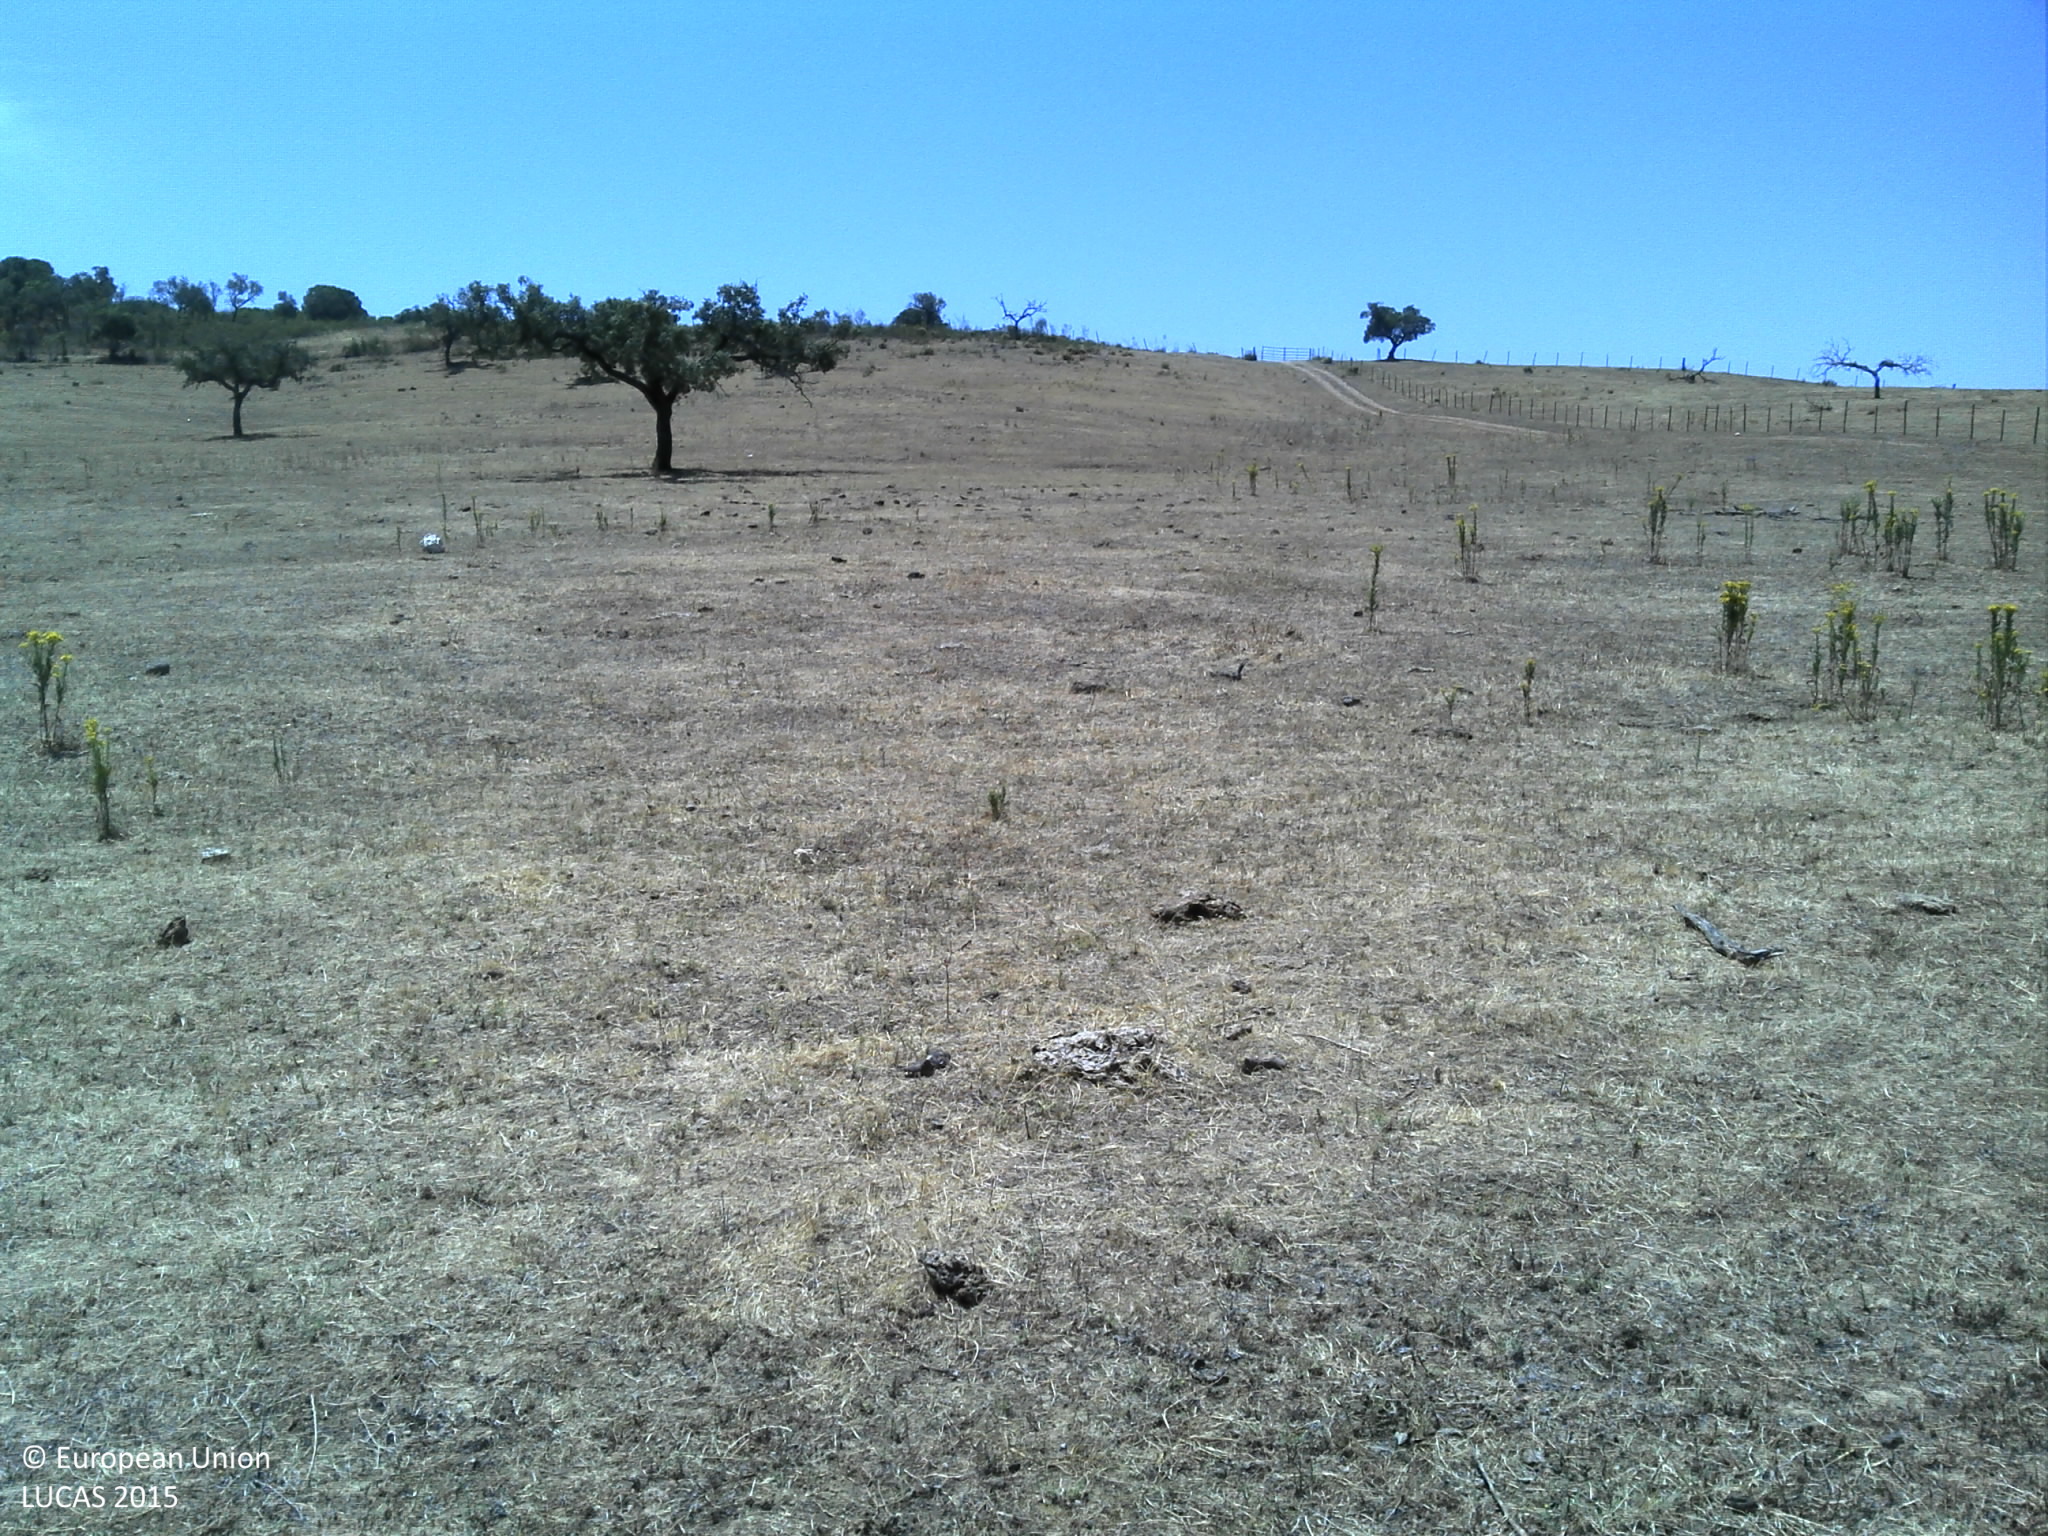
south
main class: Grassland
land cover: Grassland without tree/shrub cover
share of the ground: 25 - 50 %
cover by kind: unconsolidated bare surface 70 %, herbaceous plants 30 %
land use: Agriculture (excluding fallow land and kitchen gardens)
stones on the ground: < 10 %
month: June
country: PT
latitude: 37.8834
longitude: -7.5155
